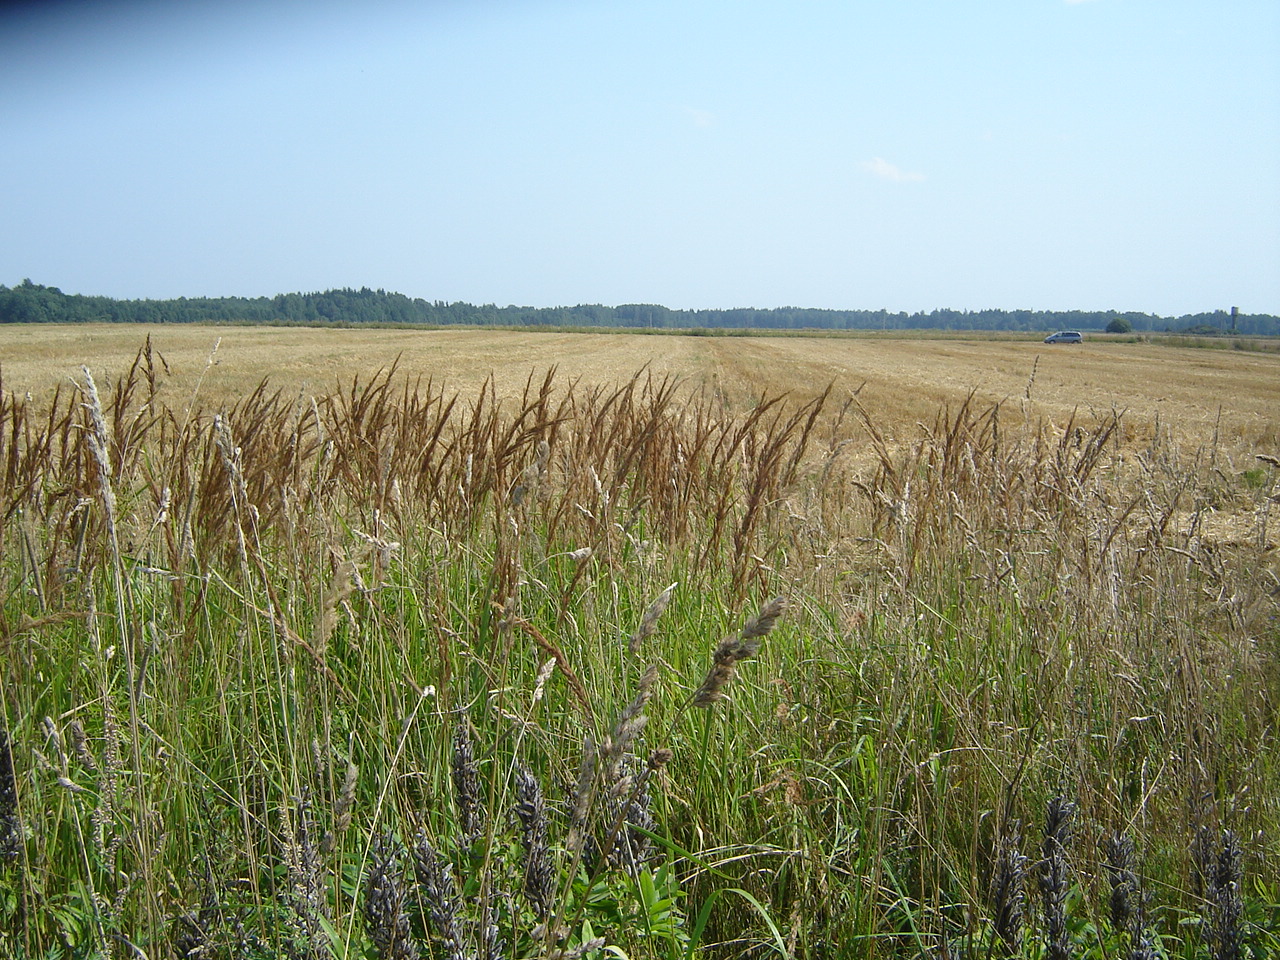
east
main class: Grassland
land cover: Spontaneously vegetated surfaces
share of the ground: > 75 %
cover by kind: herbaceous plants 100 %
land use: Fallow land
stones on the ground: < 10 %
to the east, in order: Spontaneously vegetated surfaces; Common wheat; Shruby margins; Common wheat
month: August
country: LT
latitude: 55.0177
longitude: 25.0508
